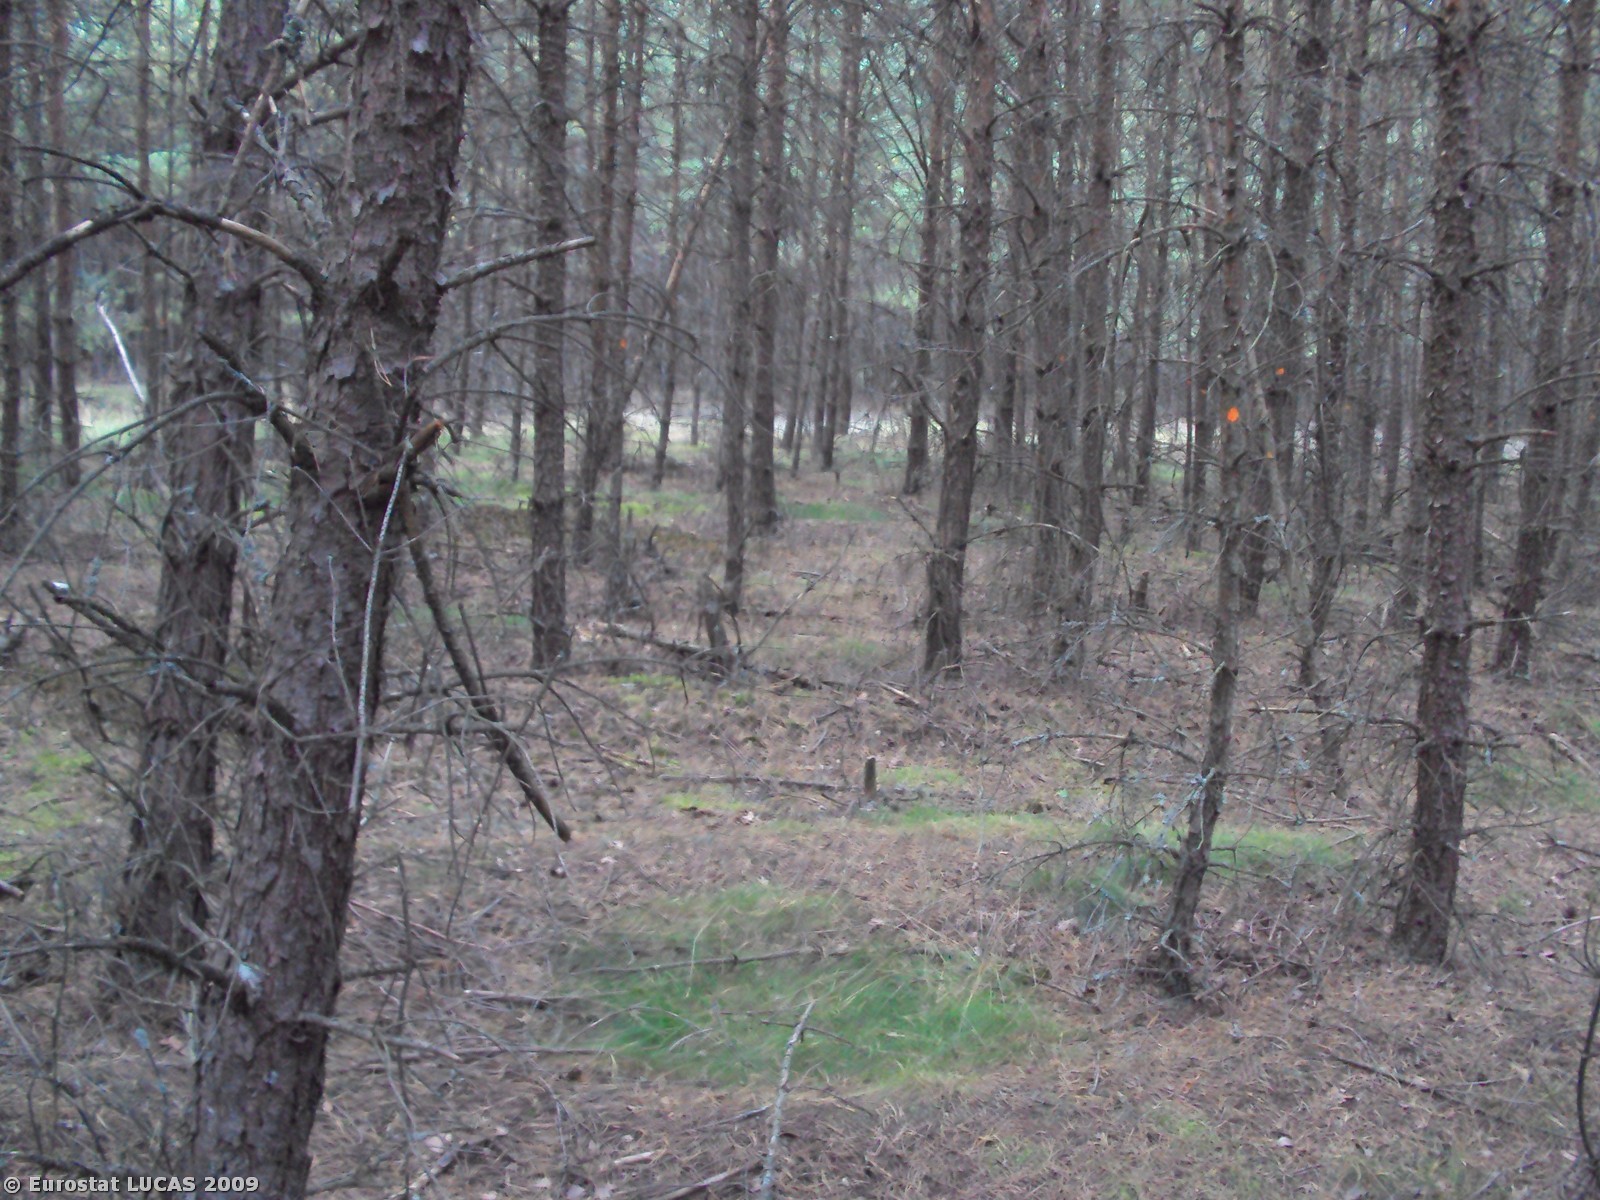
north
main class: Woodland
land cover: Coniferous woodland
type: hemiboreal forest and nemoral coniferous forest and mixed broadleaved-coniferous forest
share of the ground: > 75 %
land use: Forestry
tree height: > 5 m
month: August
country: PL
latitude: 53.4798
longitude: 16.5012
